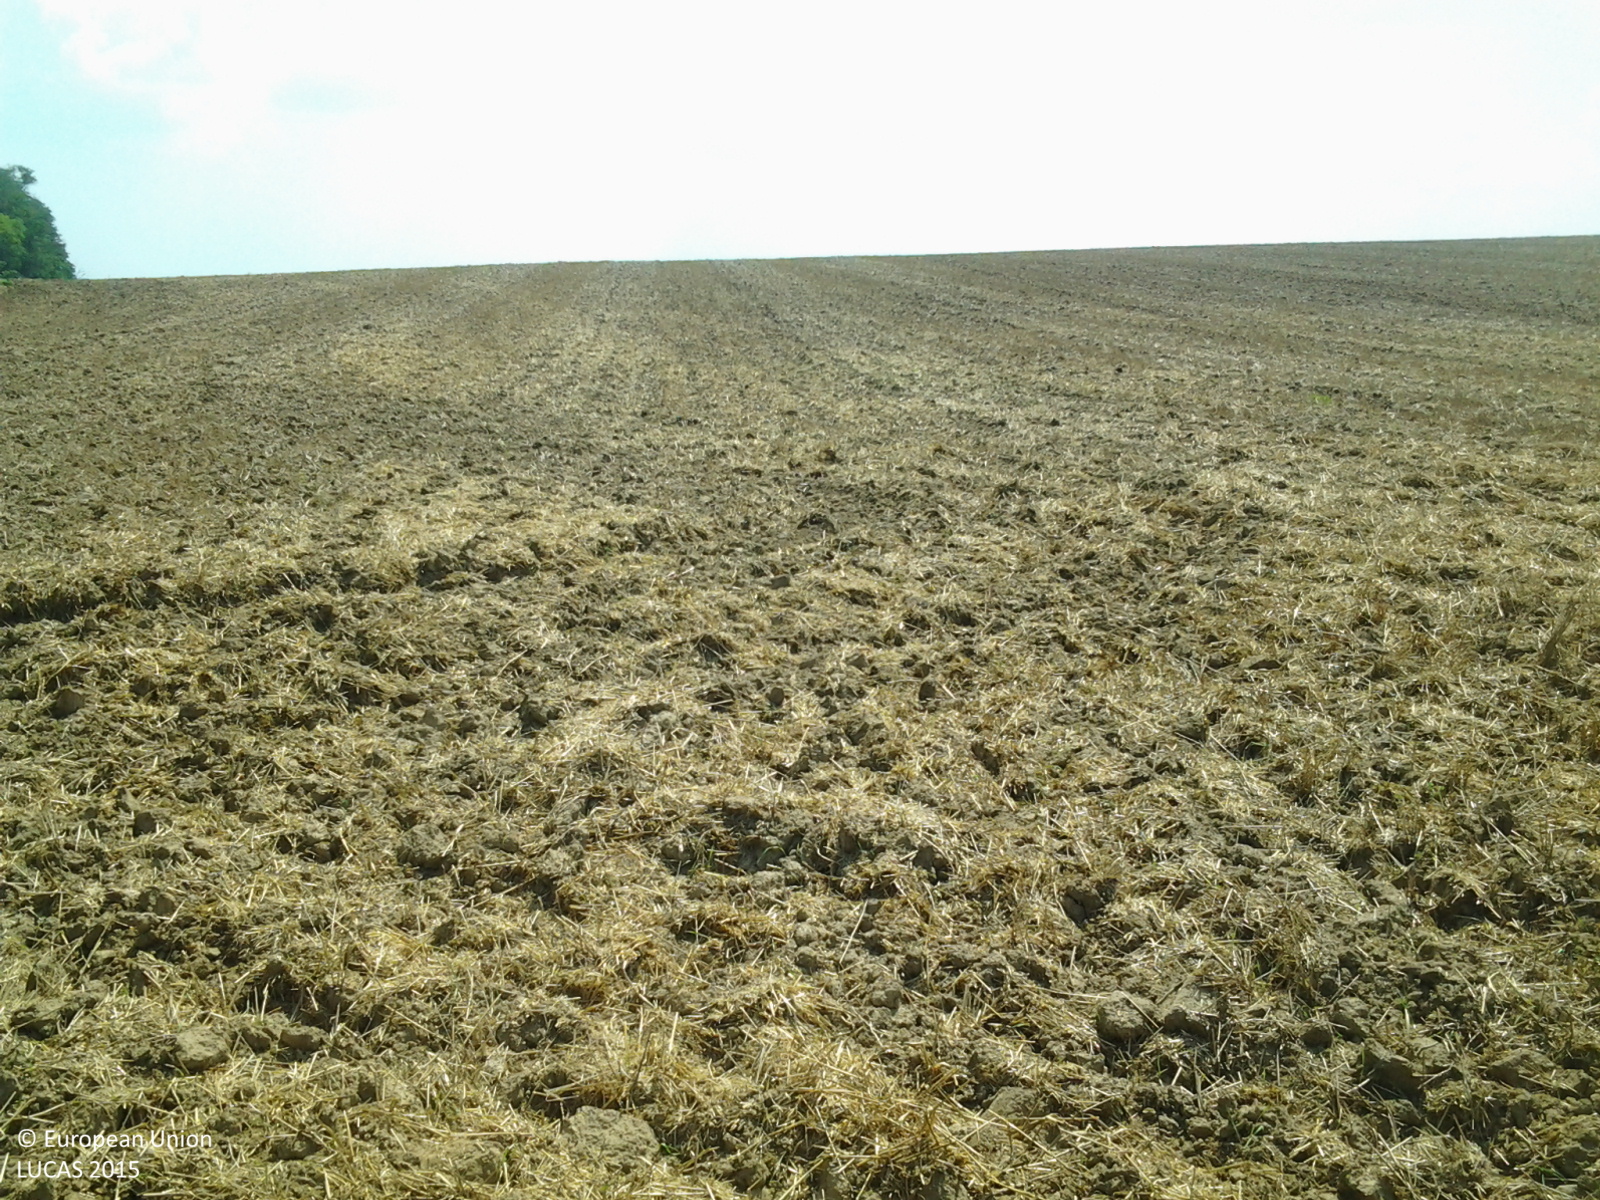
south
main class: Cropland
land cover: Triticale
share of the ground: < 10 %
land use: Agriculture (excluding fallow land and kitchen gardens)
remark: Harvested field
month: August
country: HU
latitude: 46.4505
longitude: 18.2231
